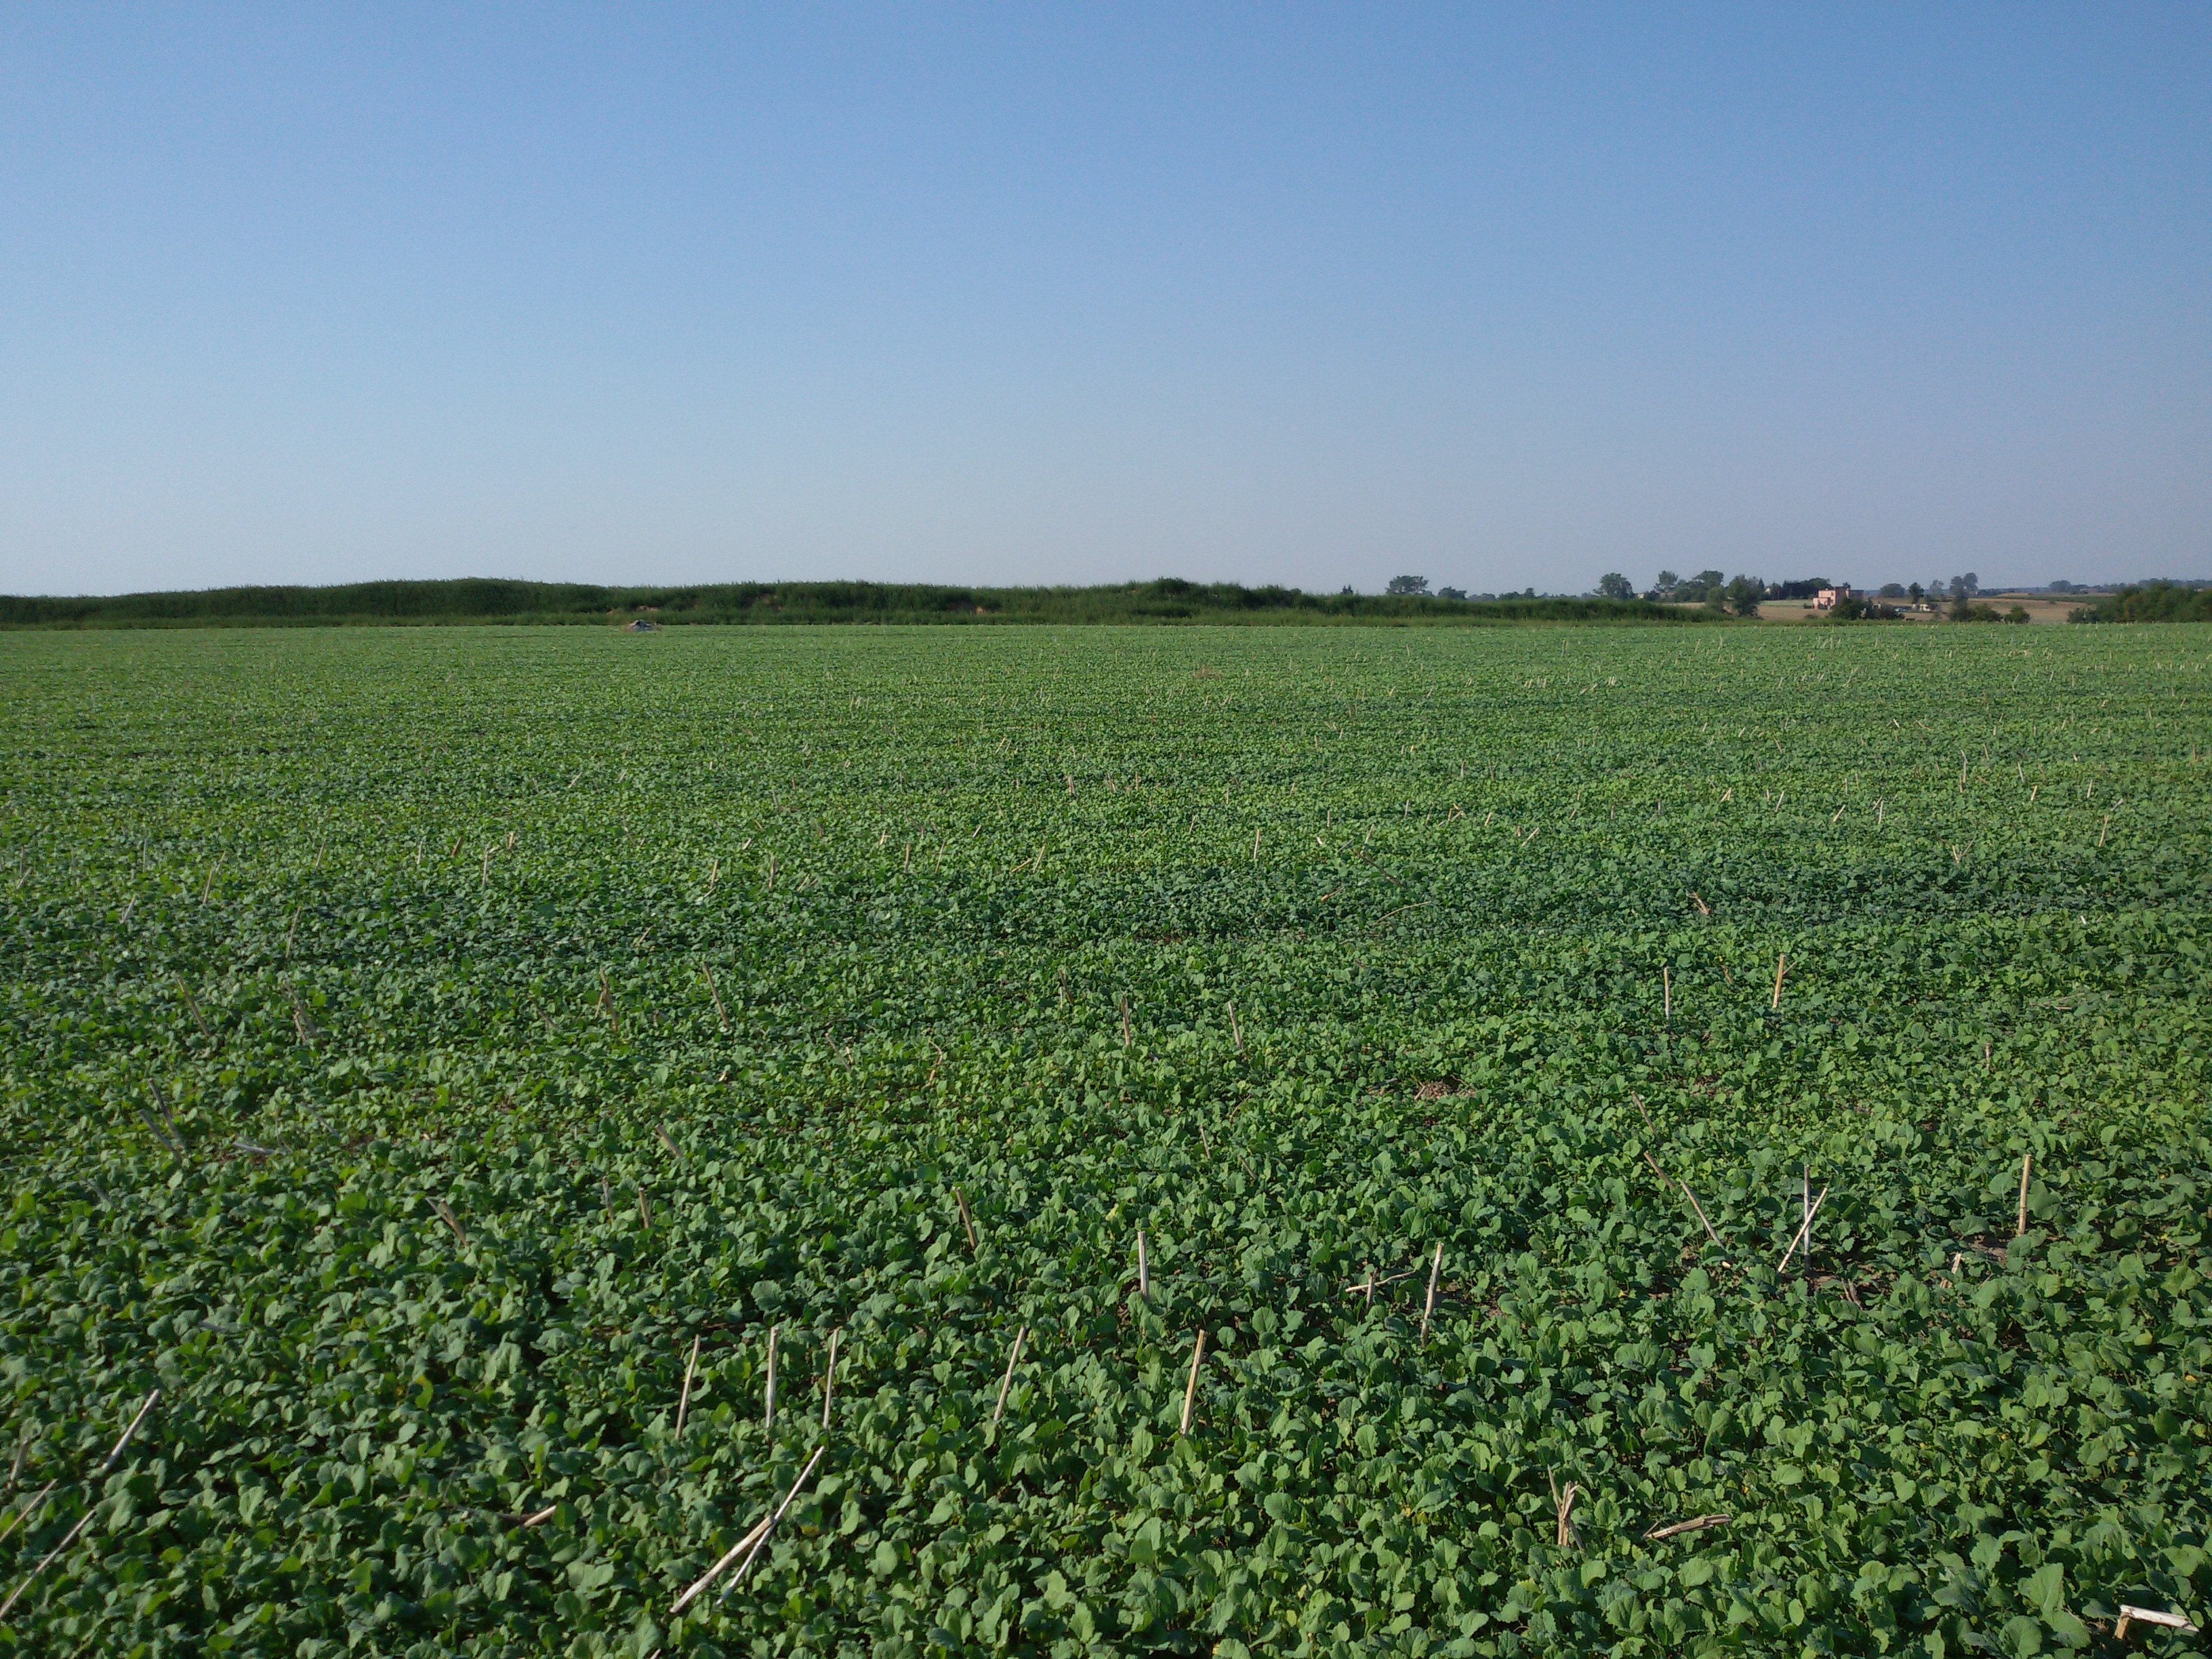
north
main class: Cropland
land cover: Rape and turnip rape
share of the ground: > 75 %
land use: Agriculture (excluding fallow land and kitchen gardens)
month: August
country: PL
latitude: 52.5683
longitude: 17.5815
